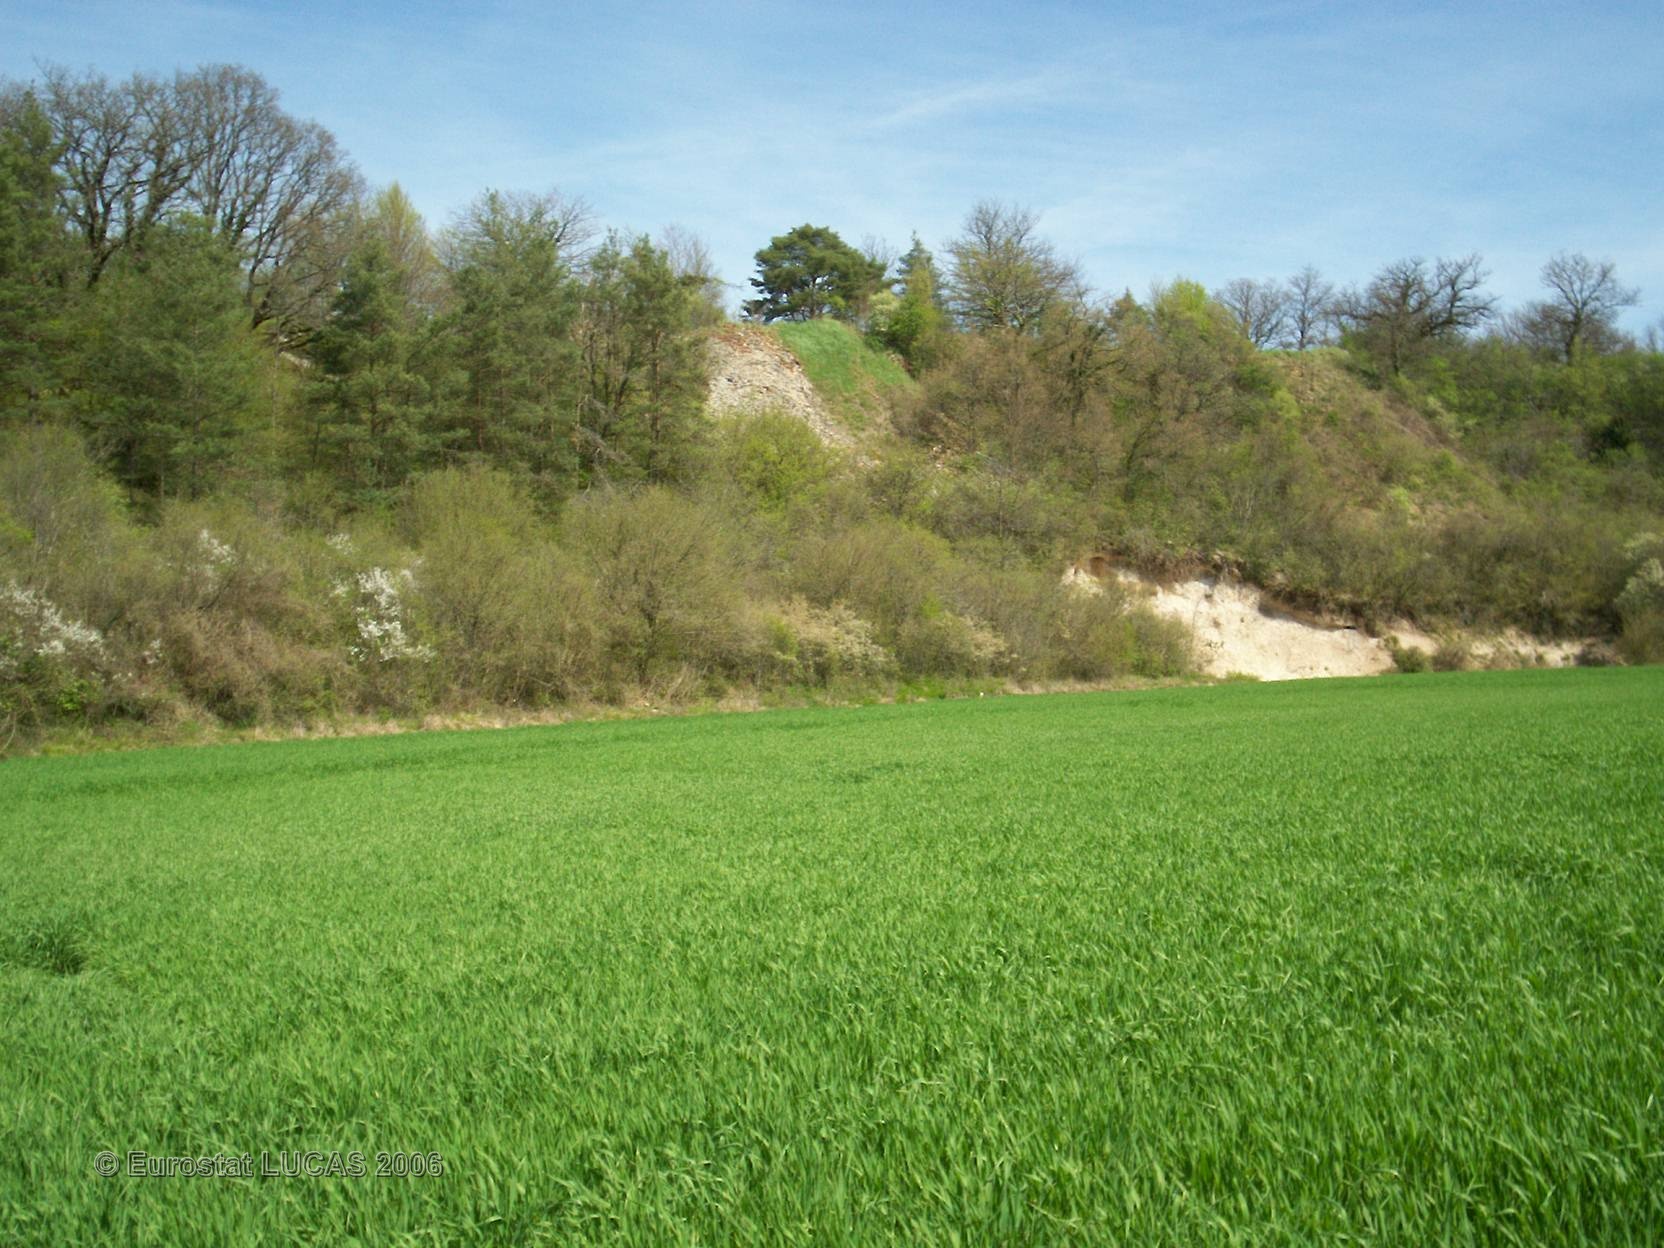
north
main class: Cropland
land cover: Barley
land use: Agriculture (excluding fallow land and kitchen gardens)
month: May
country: FR
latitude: 47.8355
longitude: 4.5341
